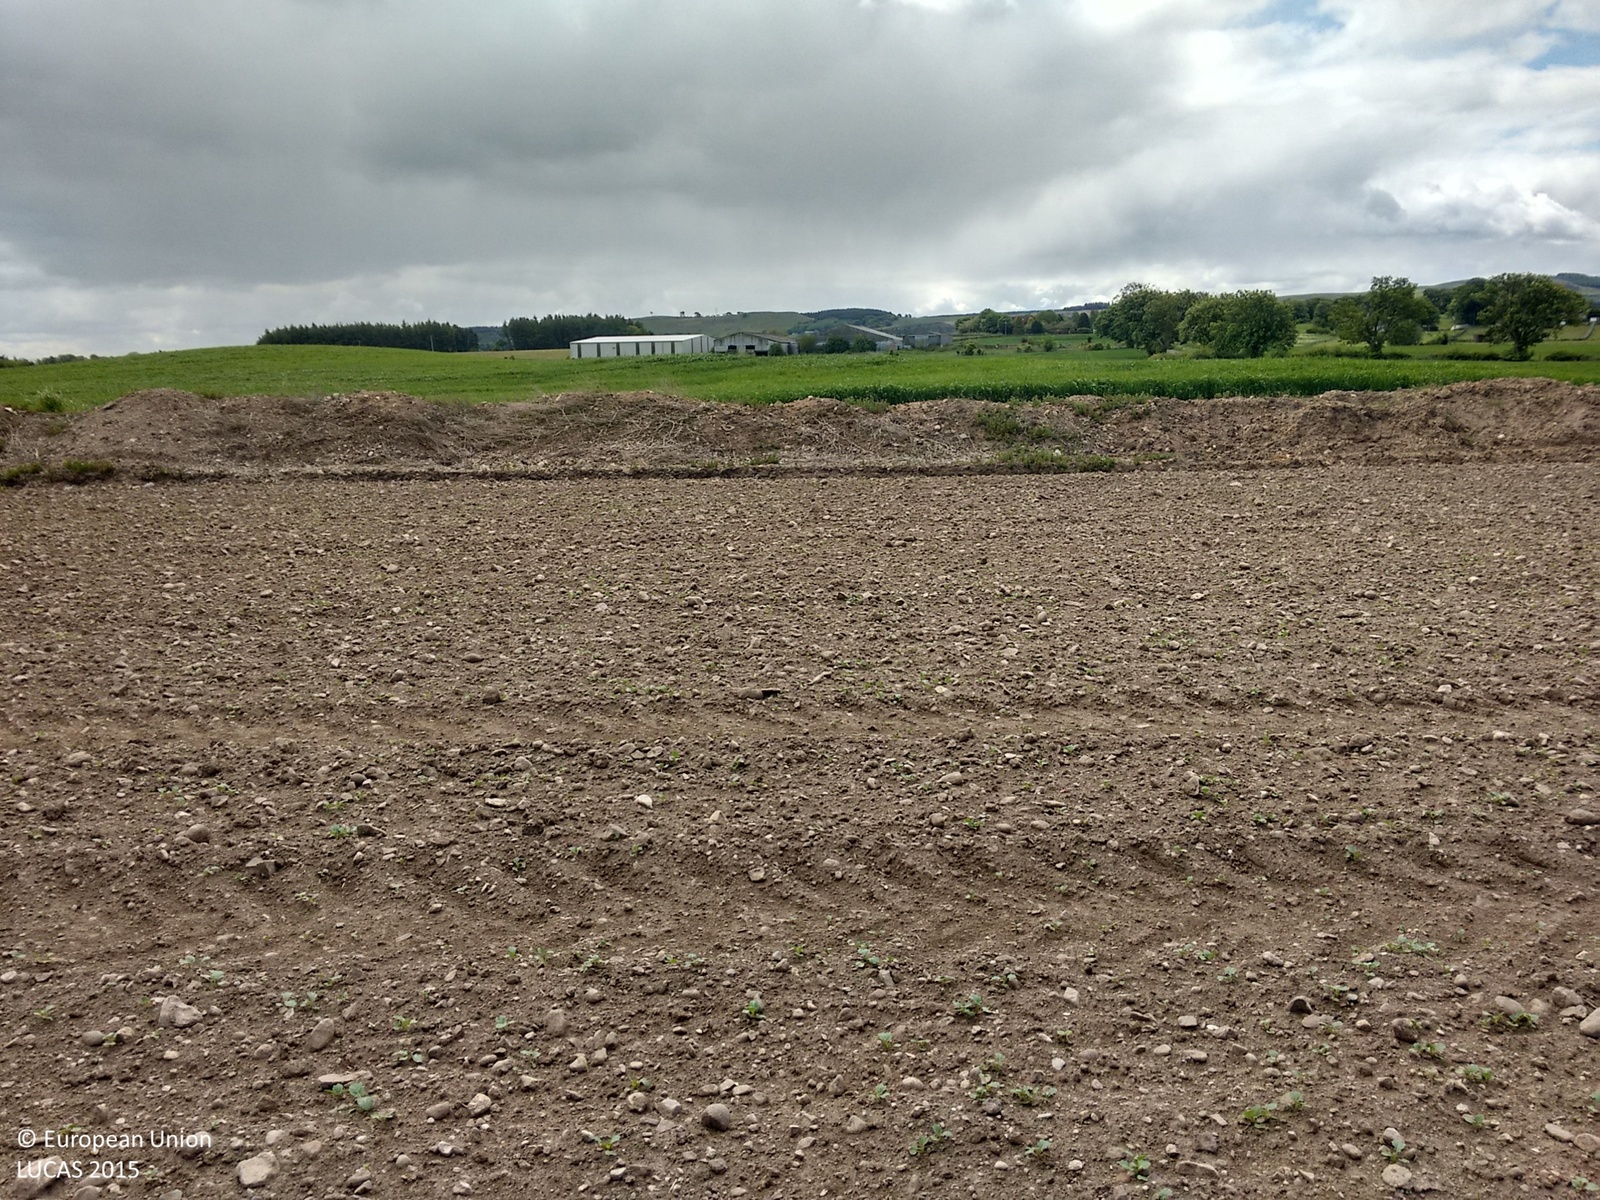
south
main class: Cropland
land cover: Rape and turnip rape
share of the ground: 10 - 25 %
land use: Agriculture (excluding fallow land and kitchen gardens)
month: June
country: GB
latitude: 56.1892
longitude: -3.4333
